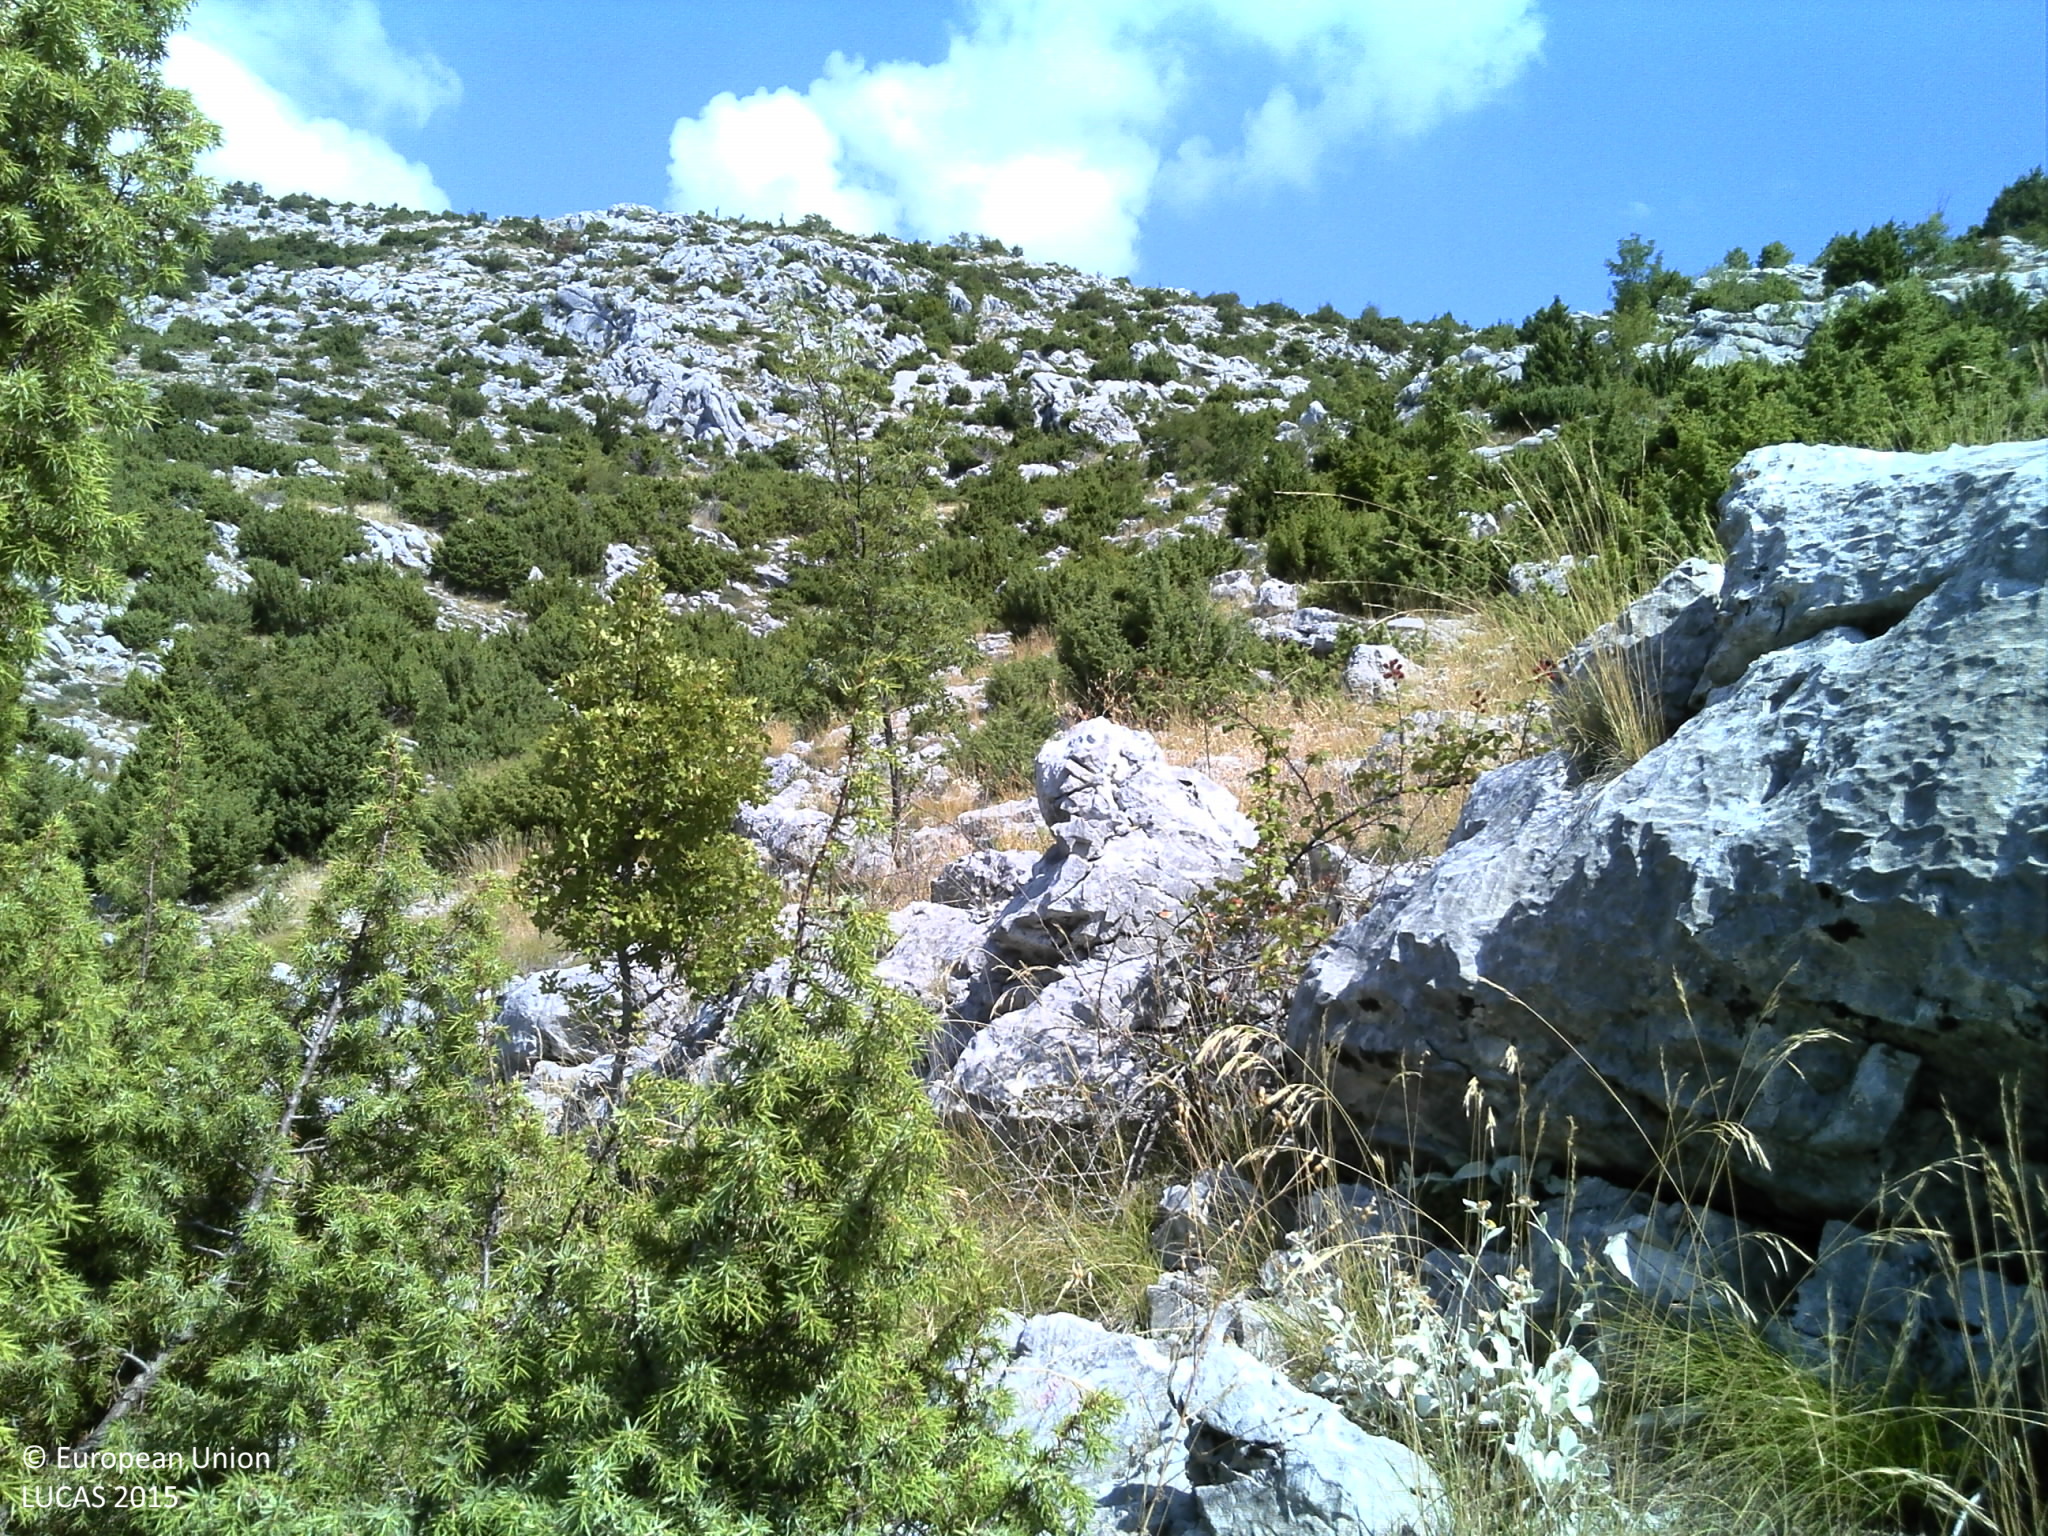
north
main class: Shrubland
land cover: Shrubland with sparse tree cover
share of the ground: > 75 %
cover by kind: shrubs 45 %, unconsolidated bare surface 25 %, herbaceous plants 20 %, coniferous forest trees 5 %, consolidated bare surface 5 %
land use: Semi-natural and natural areas not in use
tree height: < 5 m
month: August
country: HR
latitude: 43.2622
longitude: 17.2719
